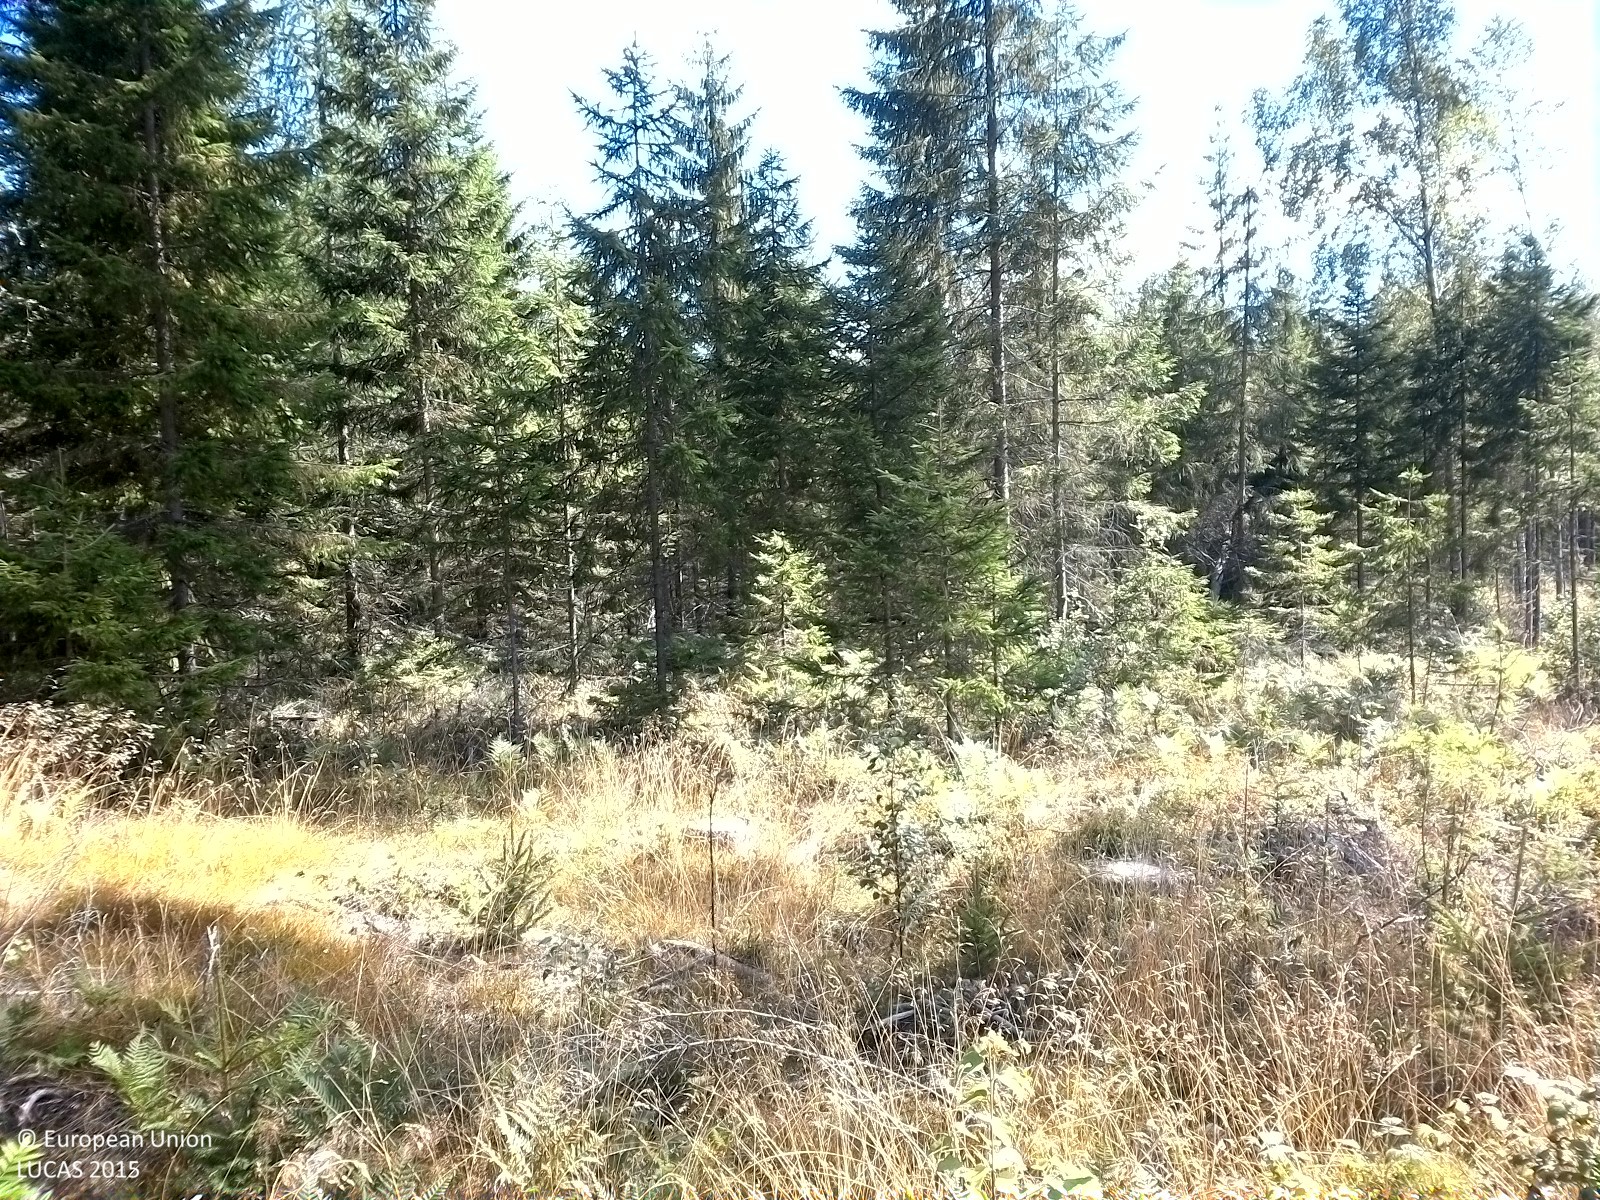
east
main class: Woodland
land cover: Other mixed woodland
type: boreal forest
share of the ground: 25 - 50 %
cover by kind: herbaceous plants 40 %, coniferous forest trees 25 %, broadleaved forest trees 20 %, shrubs 15 %
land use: Forestry
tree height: > 5 m
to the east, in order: Other mixed woodland; Spruce dominated coniferous woodland; Other coniferous woodland; Ditches and canals; Pine dominated coniferous woodland; Other mixed woodland; Ditches and canals; Spruce dominated mixed woodland; Other coniferous woodland
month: August
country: SE
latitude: 59.1481
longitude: 14.6597
